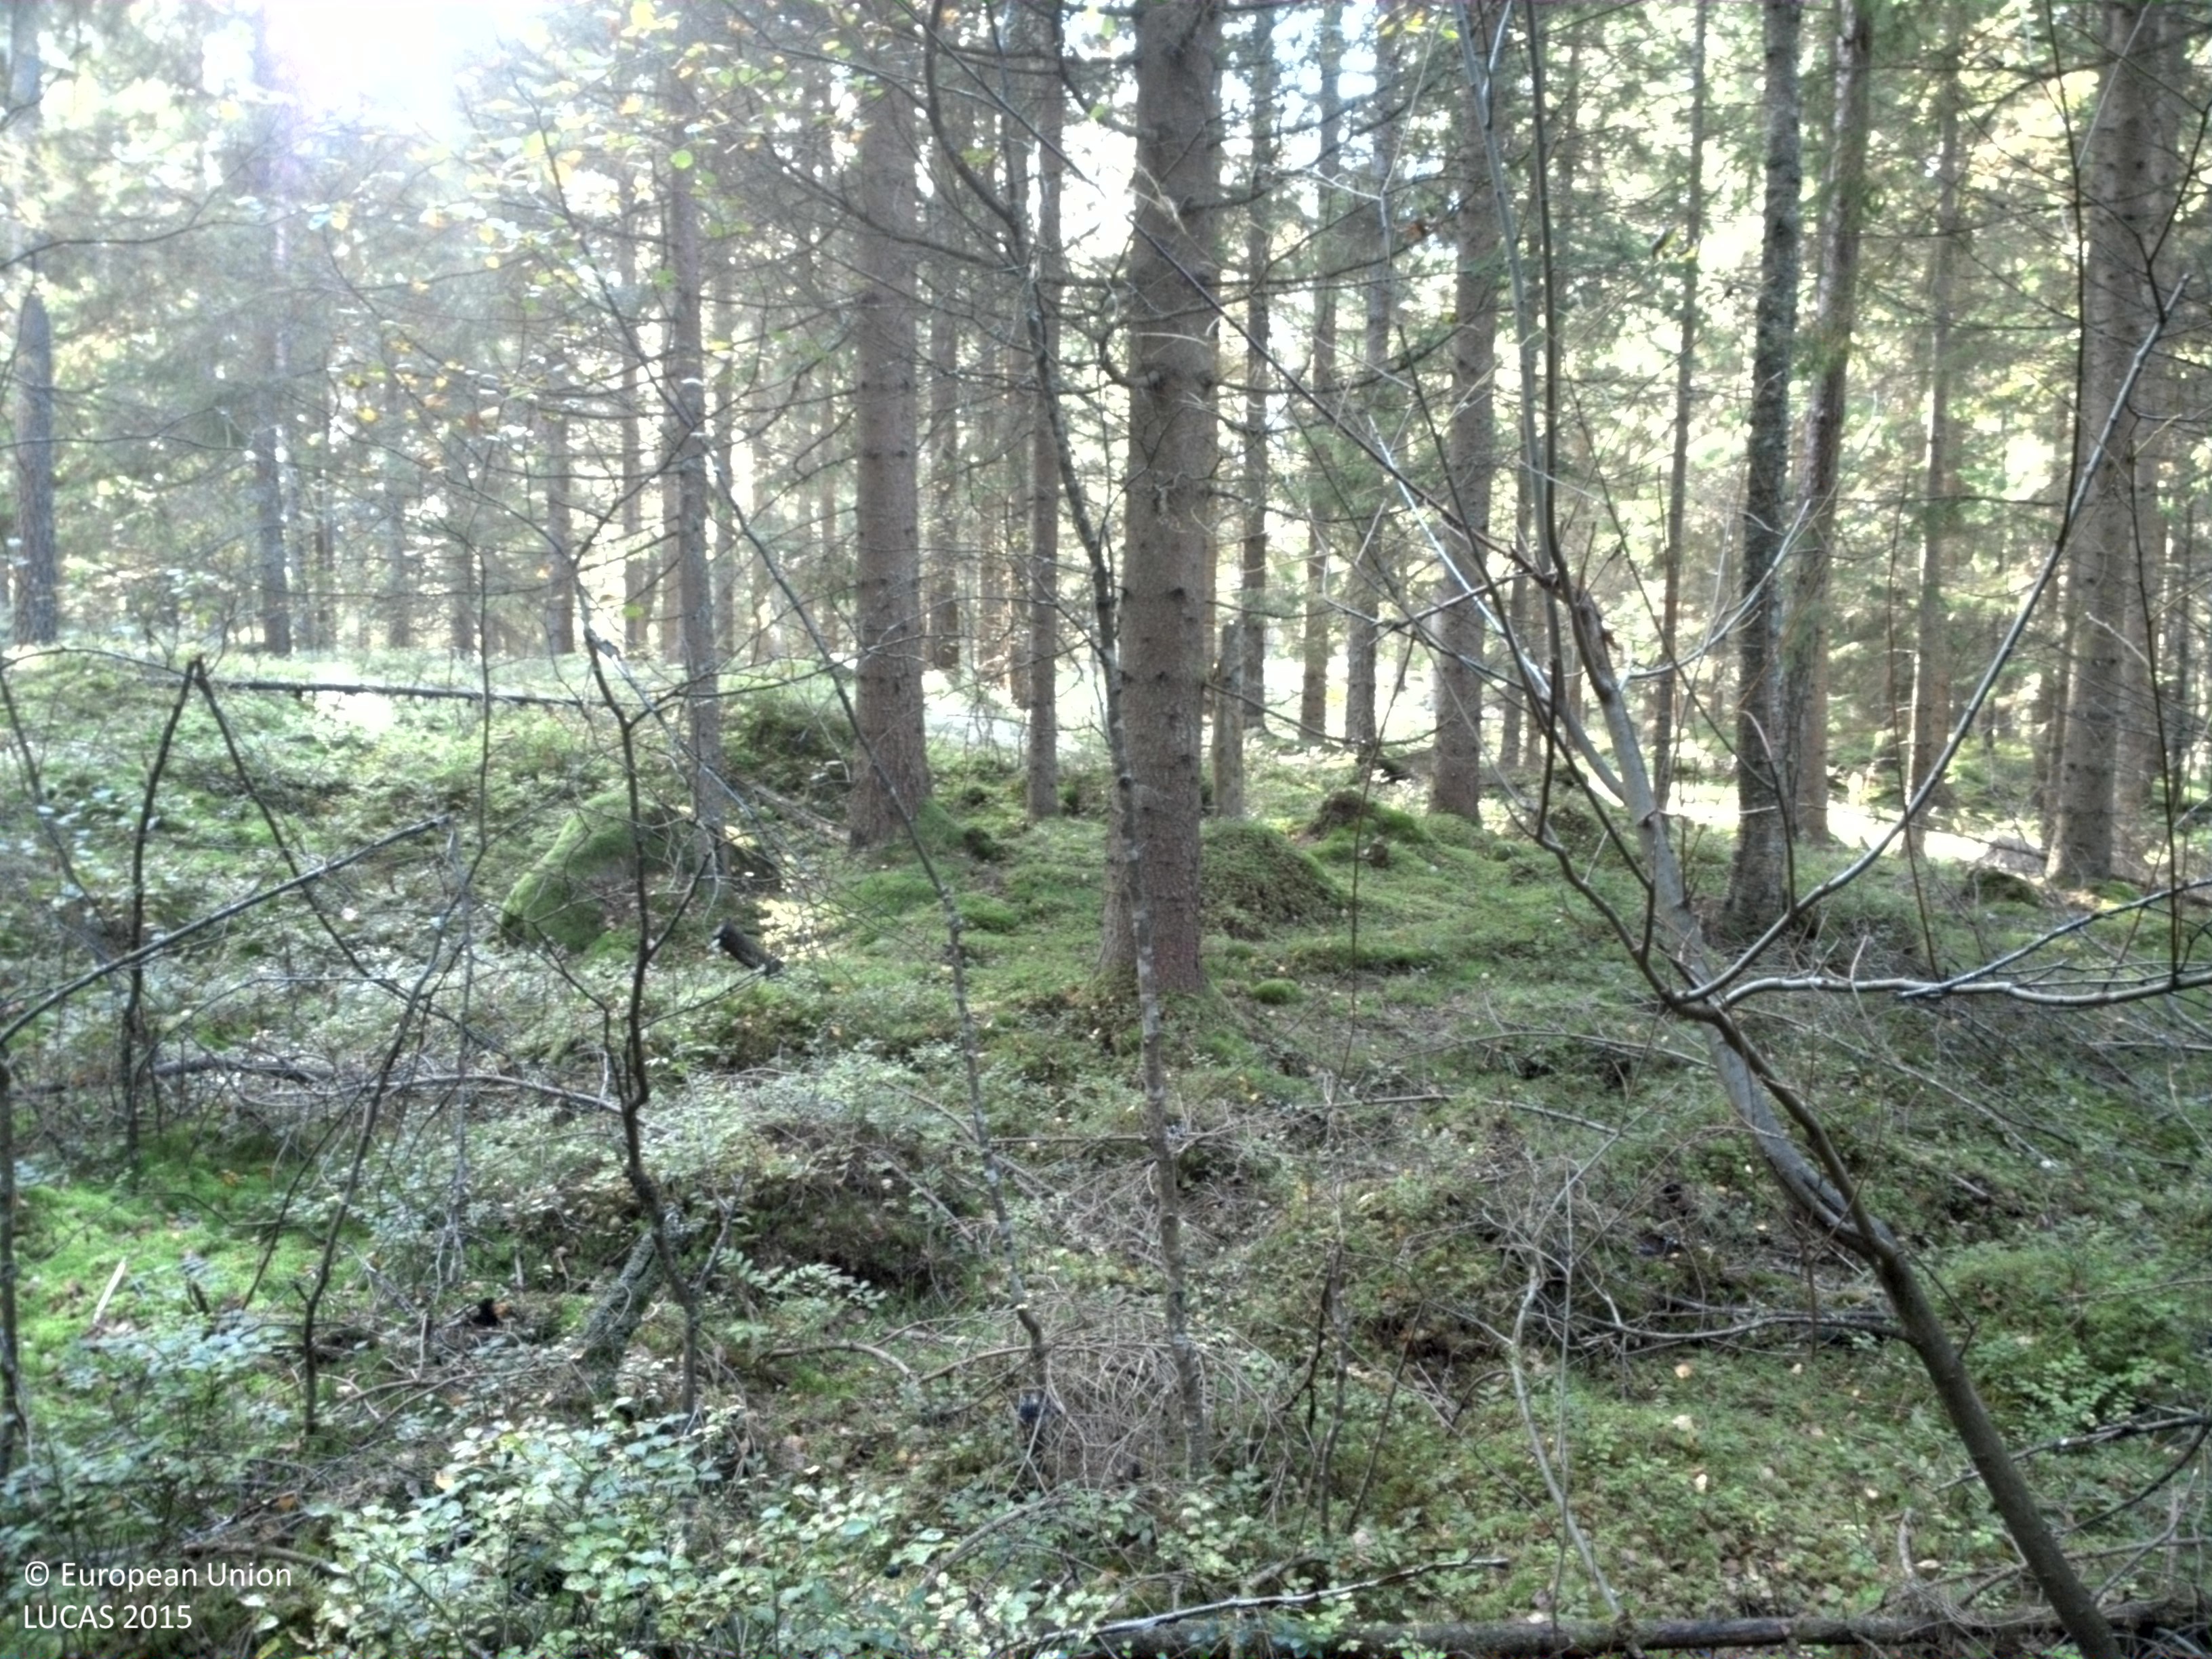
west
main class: Woodland
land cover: Spruce dominated mixed woodland
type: boreal forest
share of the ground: 50 - 75 %
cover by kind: coniferous forest trees 40 %, broadleaved forest trees 20 %, shrubs 20 %, lichens and mosses 20 %
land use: Forestry
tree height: > 5 m
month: September
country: SE
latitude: 57.8970
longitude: 13.0488
